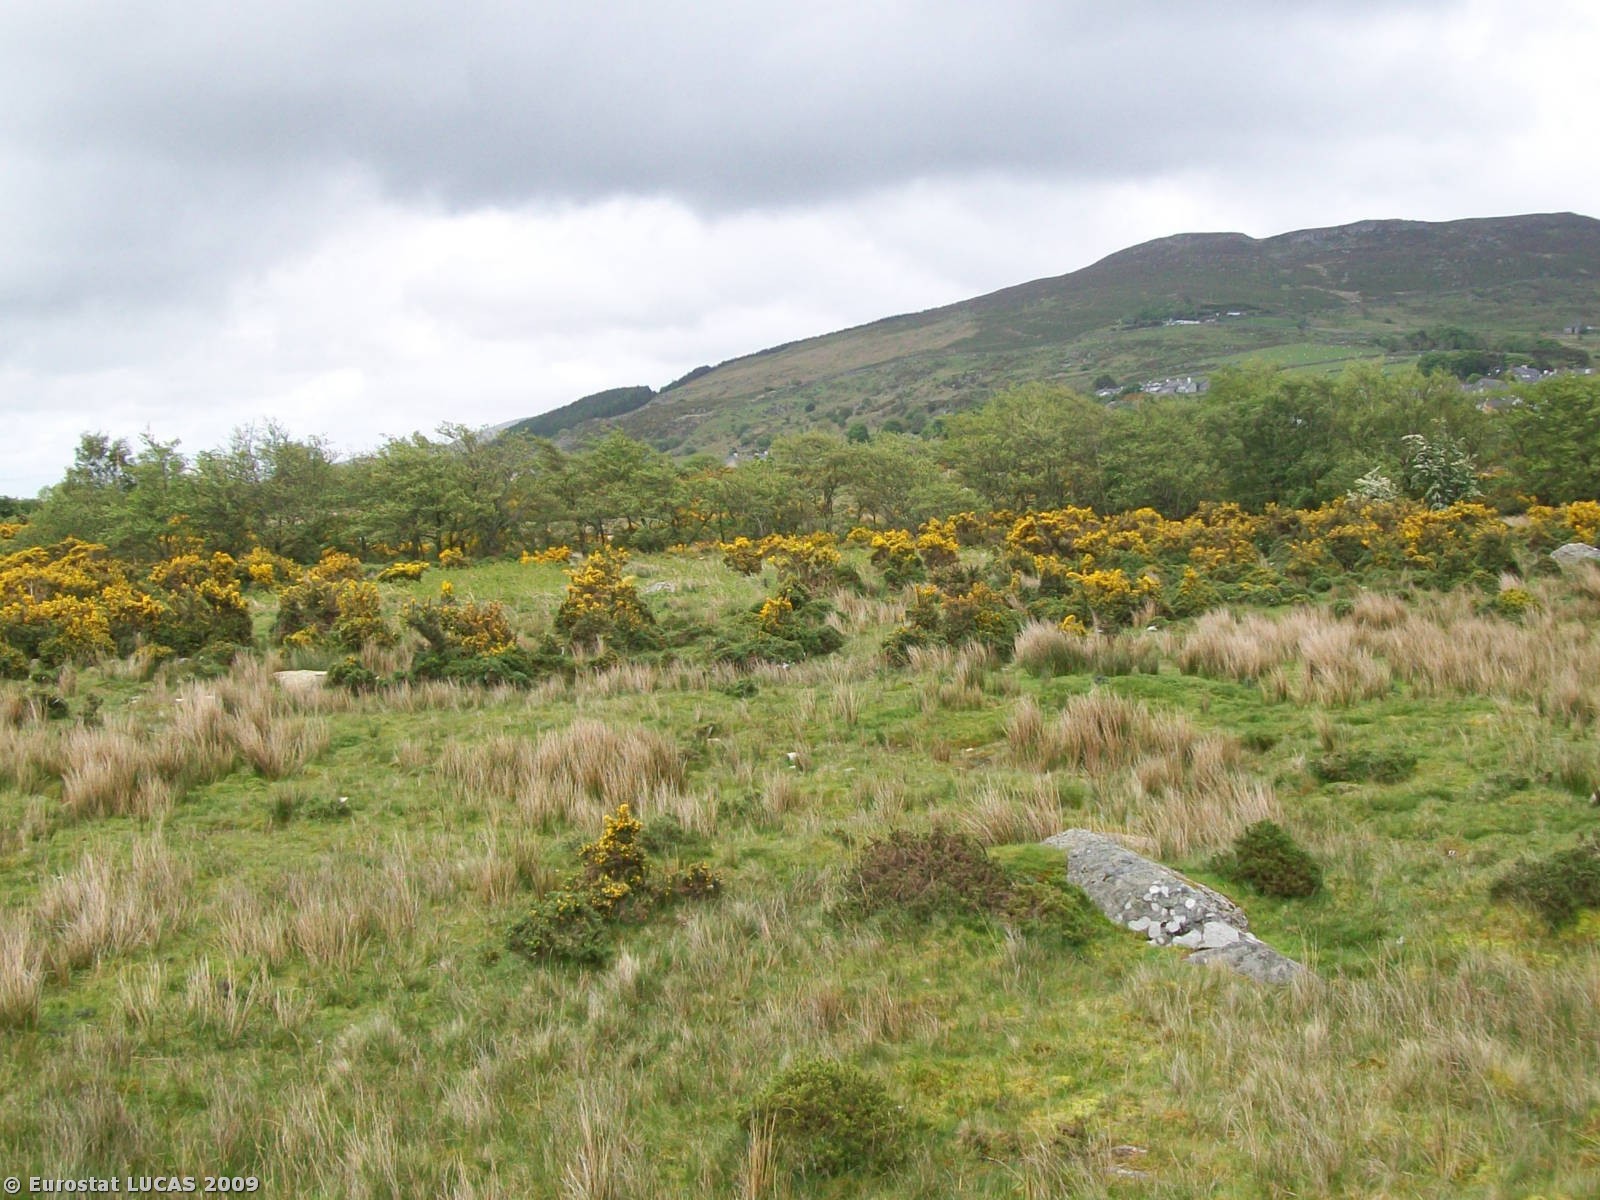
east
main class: Shrubland
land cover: Shrubland without tree cover
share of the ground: > 75 %
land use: Agriculture (excluding fallow land and kitchen gardens)
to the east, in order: Shrubland without tree cover; Ditches and canals; Shrubland without tree cover; Fences; Shrubland without tree cover; Fences; Ditches and canals
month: May
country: GB
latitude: 53.1689
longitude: -4.1438
